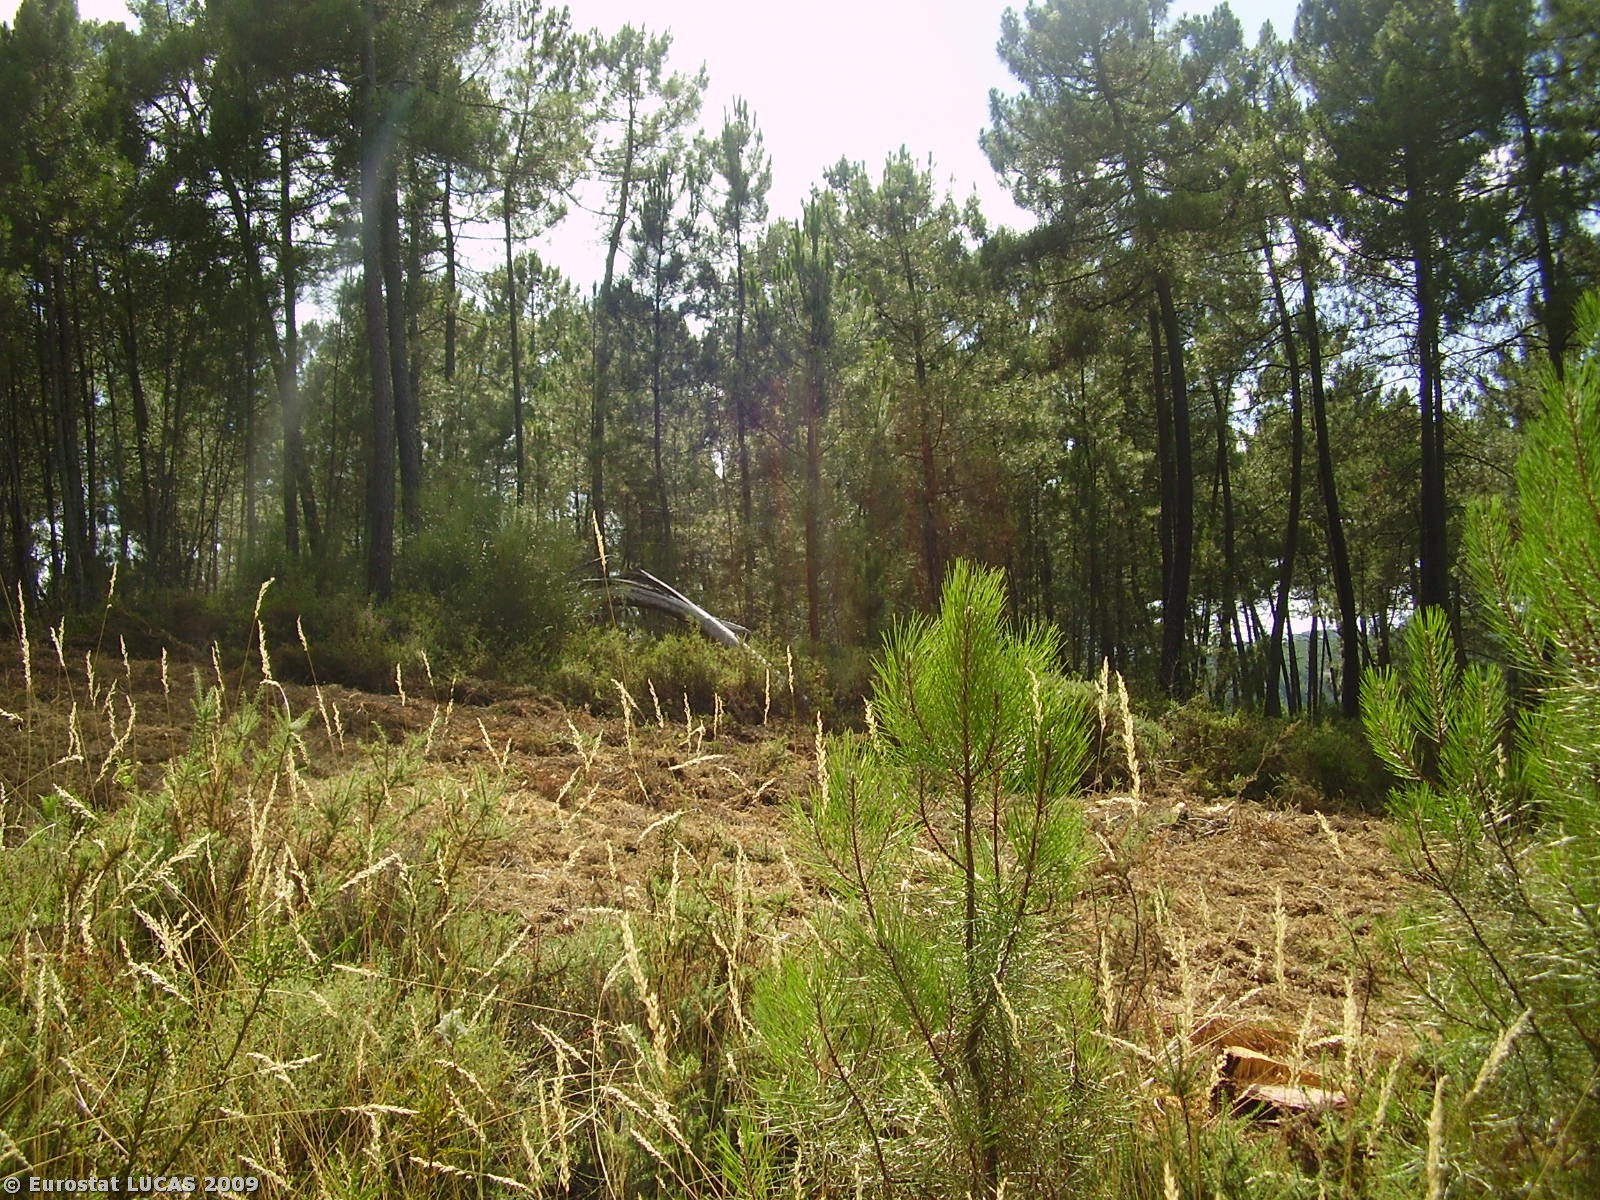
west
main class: Woodland
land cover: Coniferous woodland
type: coniferous forest of the mediterranean region
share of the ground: 50 - 75 %
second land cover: Spontaneously vegetated surfaces
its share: 10 - 25 %
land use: Forestry
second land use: Unused
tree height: > 5 m
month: July
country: PT
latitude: 41.2405
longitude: -7.6308
